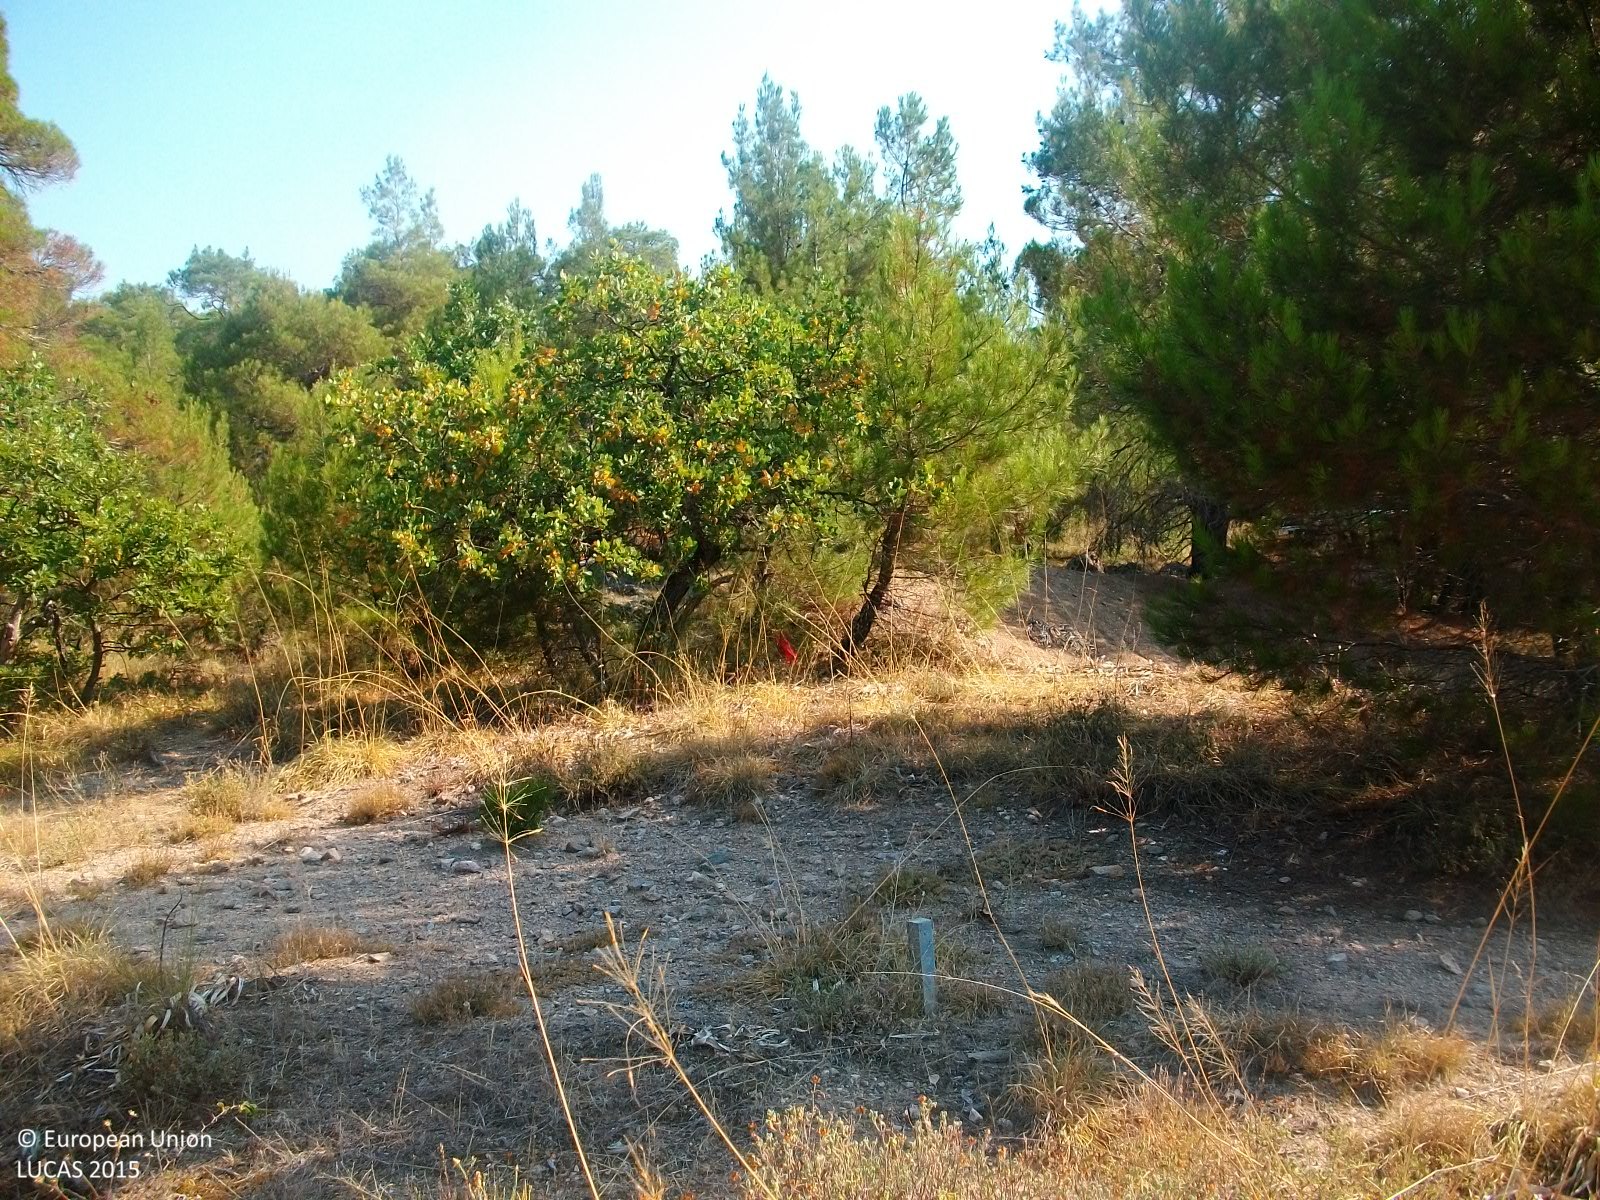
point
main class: Woodland
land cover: Pine dominated coniferous woodland
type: coniferous forest of the mediterranean region
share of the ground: 50 - 75 %
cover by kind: coniferous forest trees 60 %, herbaceous plants 20 %, broadleaved forest trees 10 %, consolidated bare surface 10 %
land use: Forestry
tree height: > 5 m
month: July
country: GR
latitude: 41.0616
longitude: 26.2139
